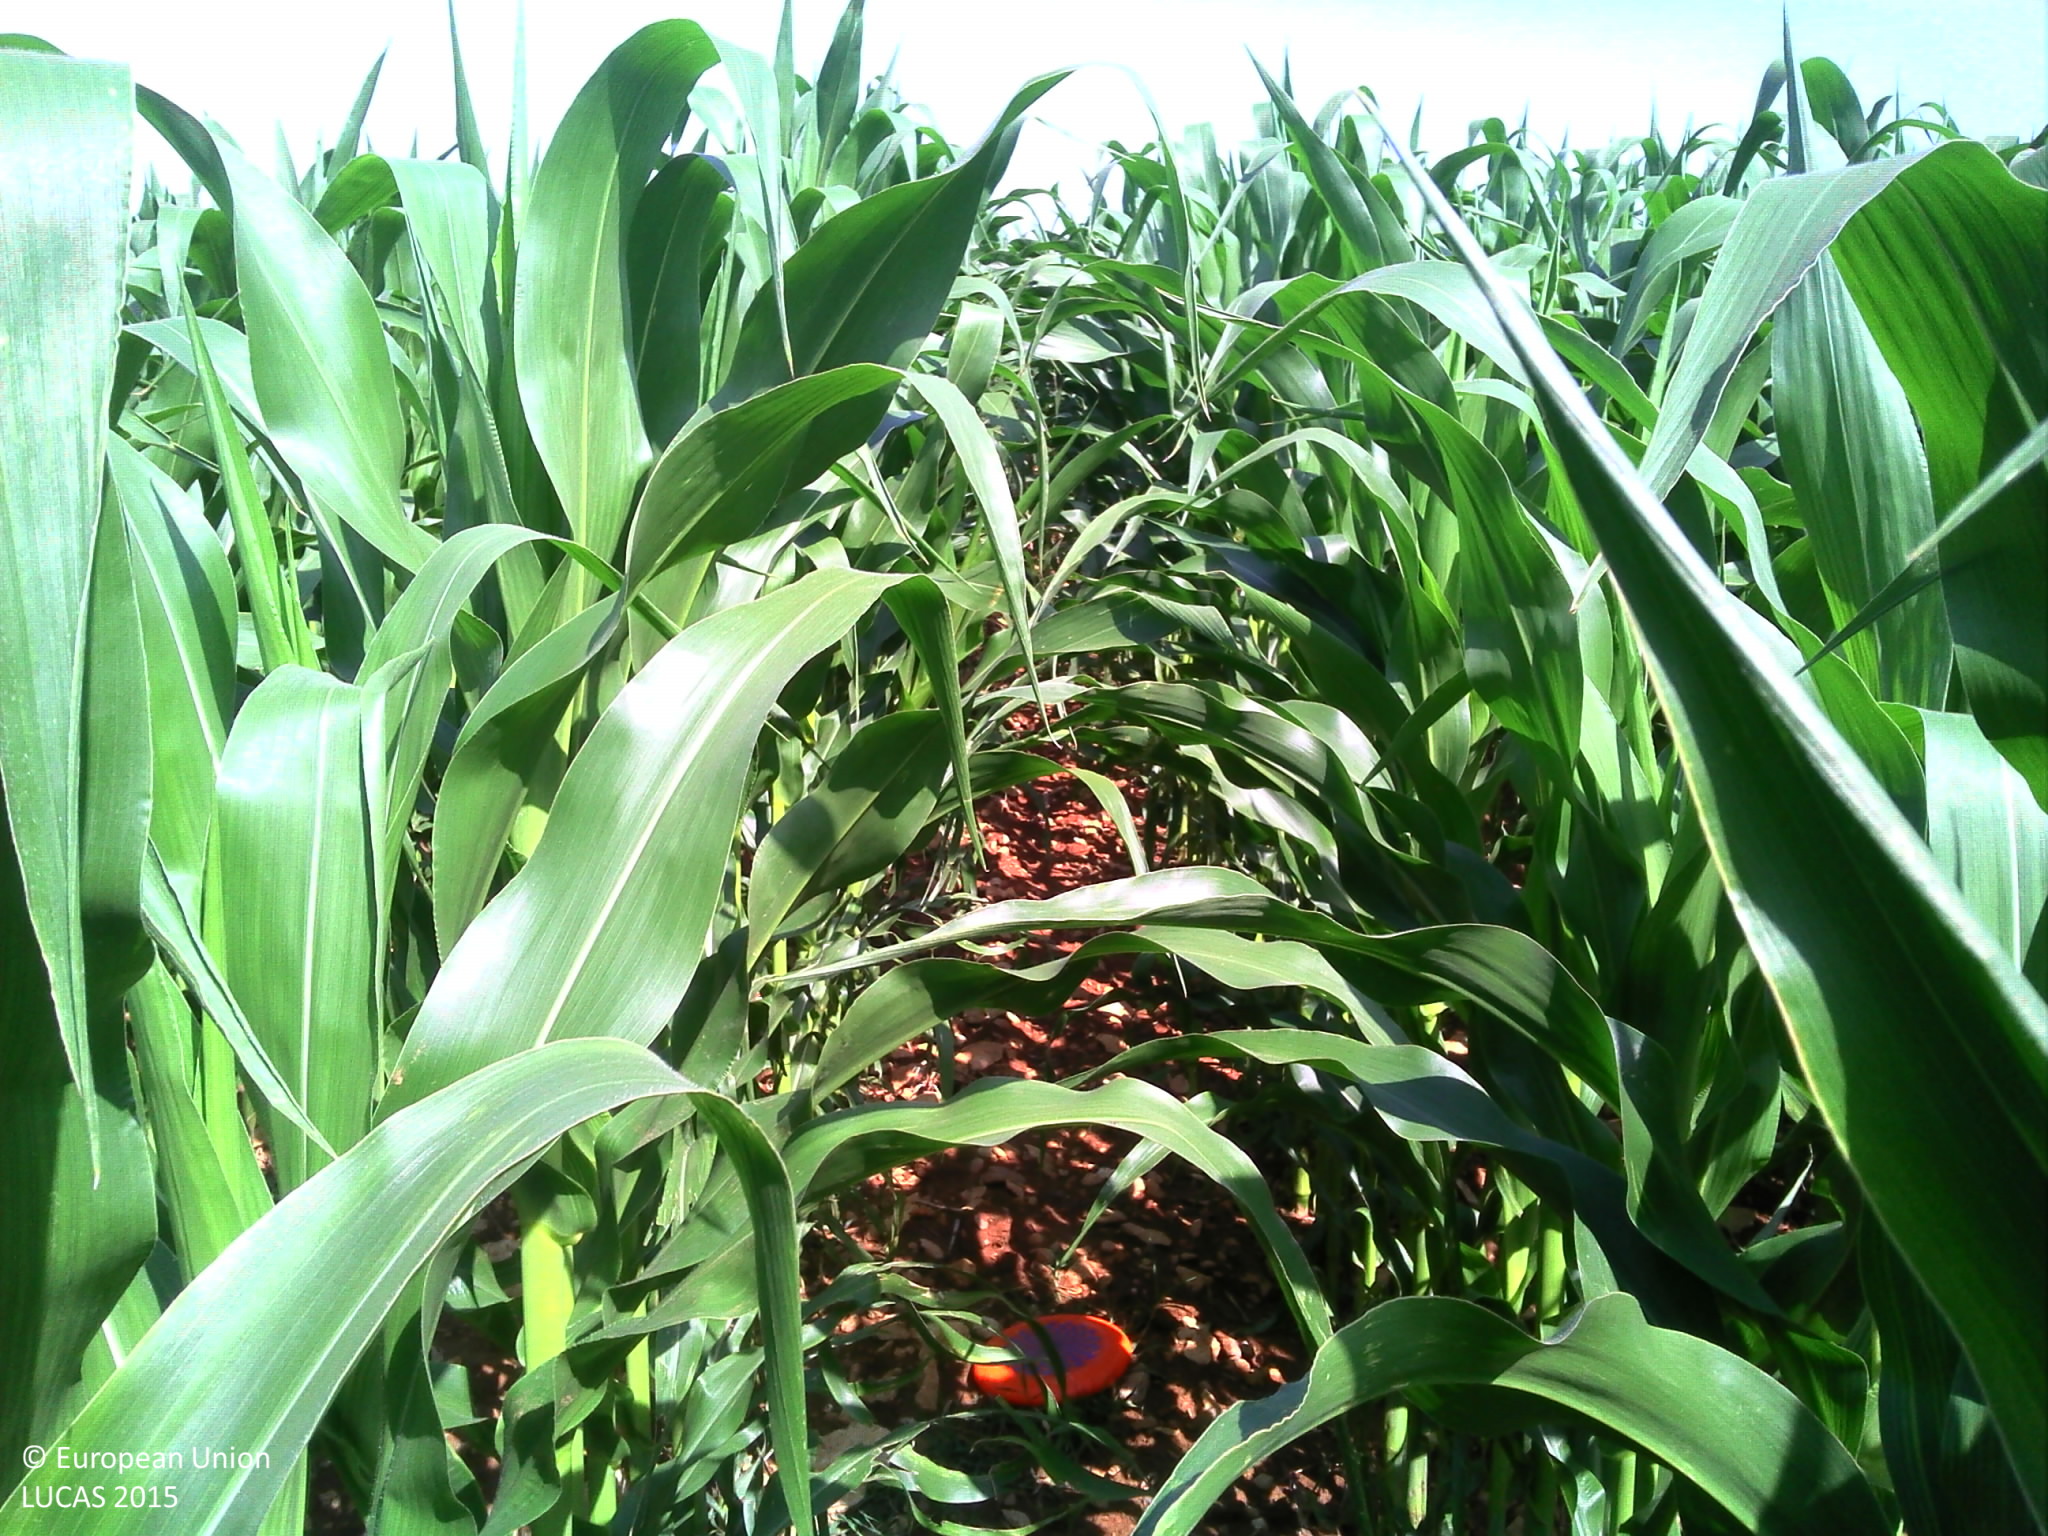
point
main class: Cropland
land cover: Maize
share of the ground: > 75 %
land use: Agriculture (excluding fallow land and kitchen gardens)
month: July
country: FR
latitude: 45.7815
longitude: 5.3608
